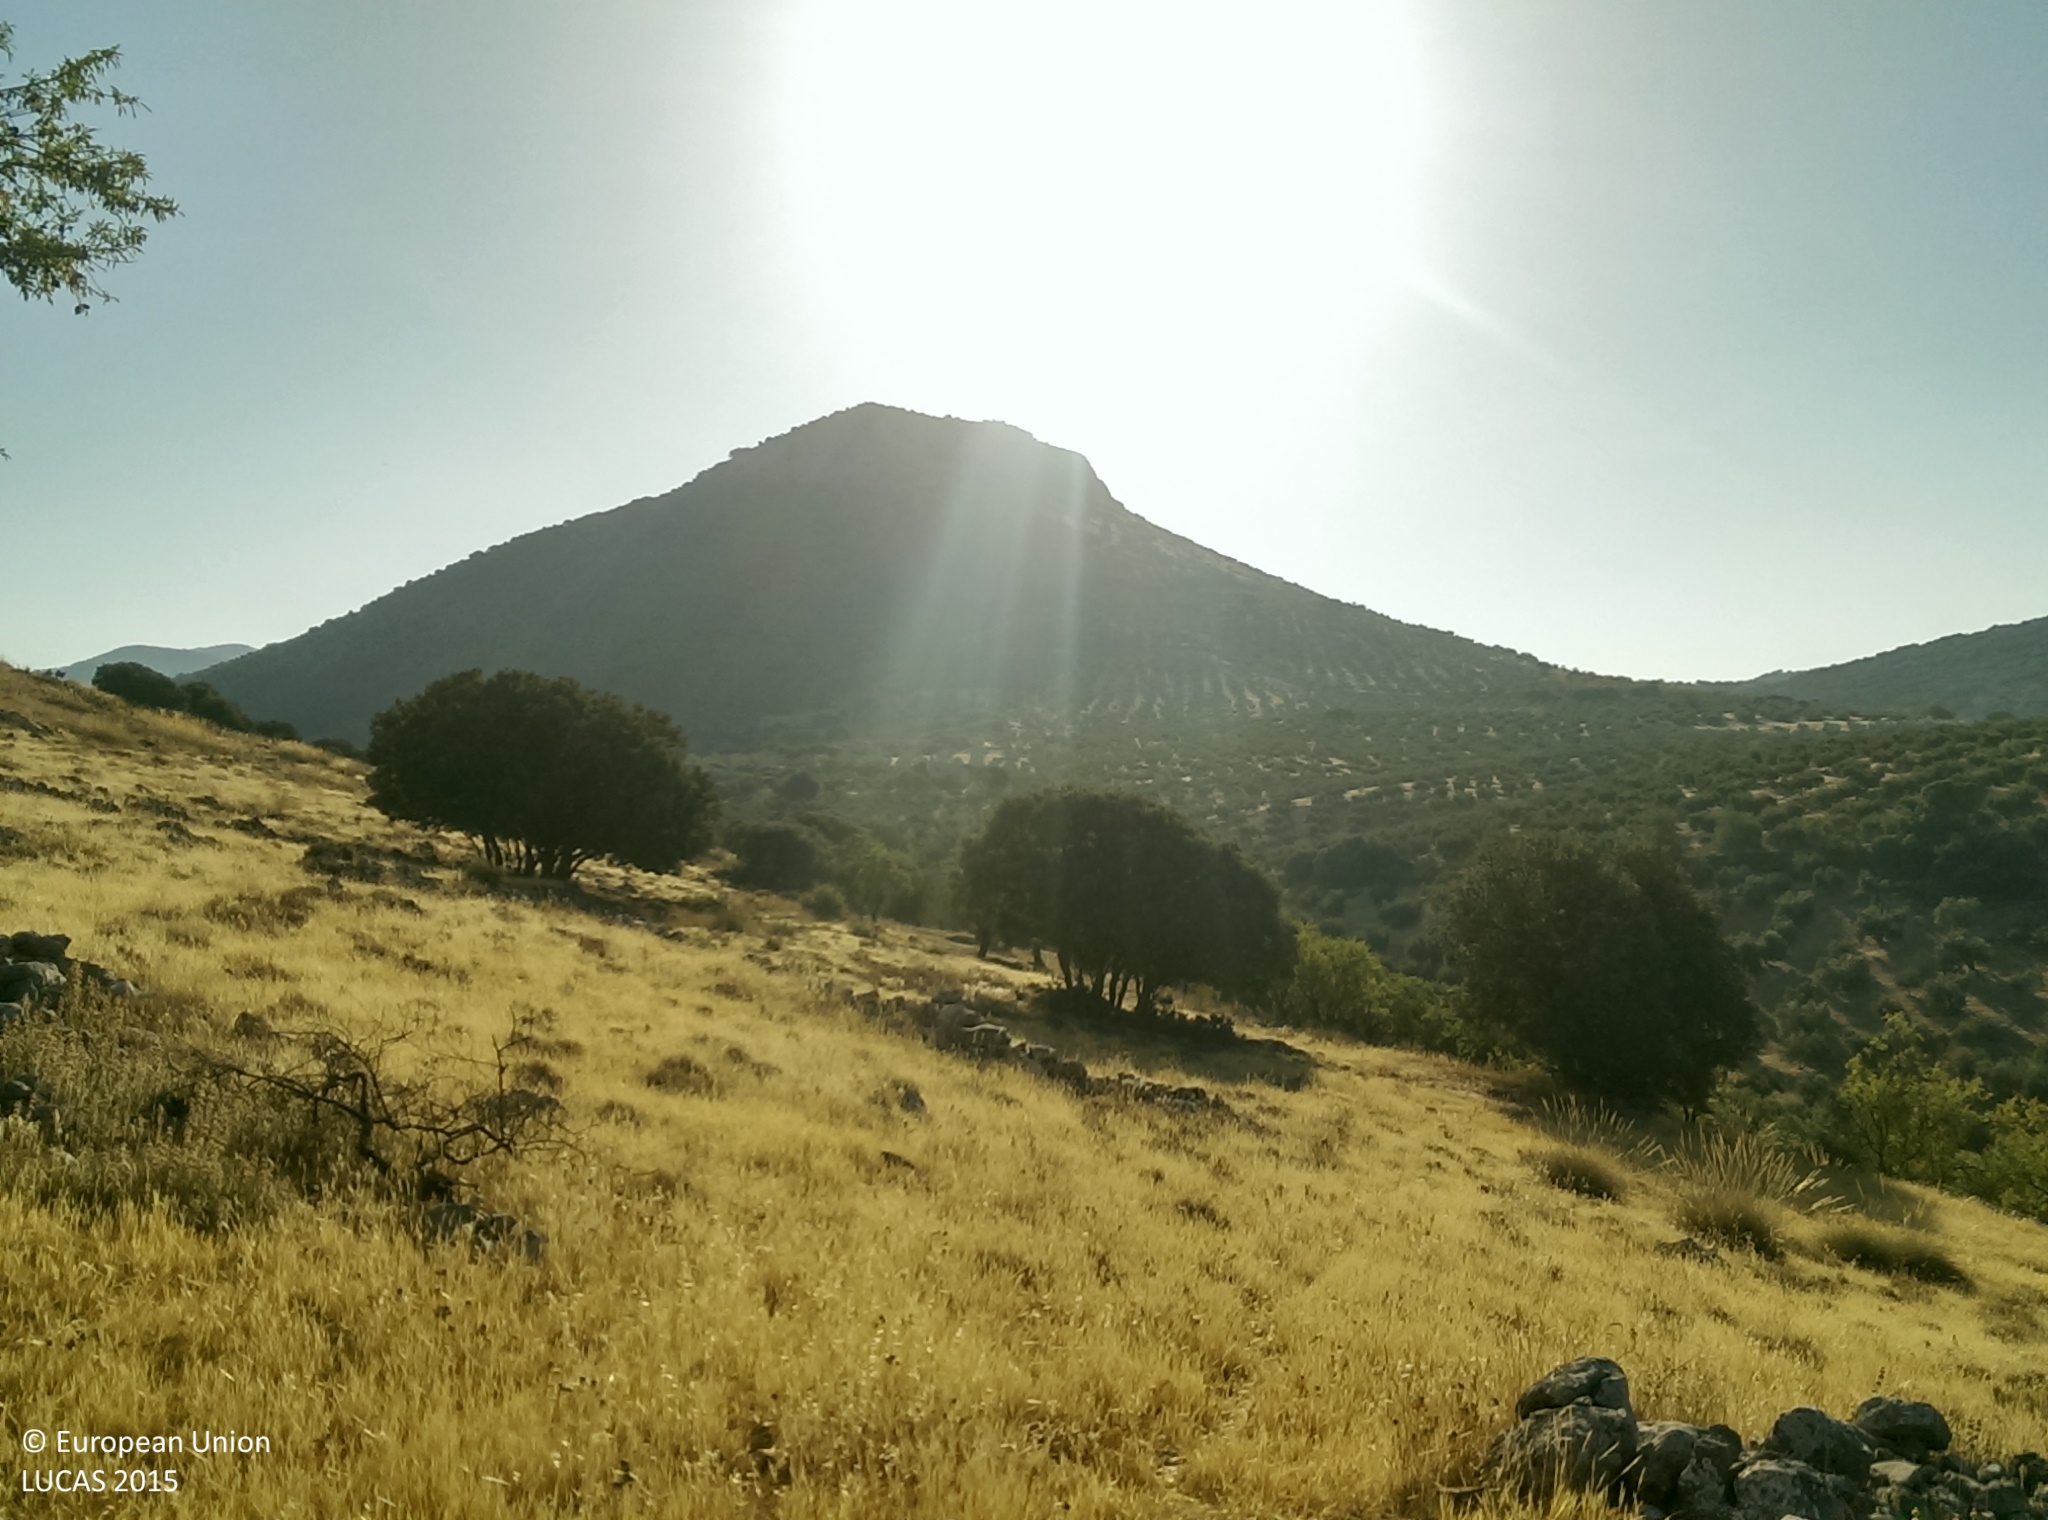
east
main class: Grassland
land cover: Grassland without tree/shrub cover
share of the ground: > 75 %
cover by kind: herbaceous plants 100 %
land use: Agriculture (excluding fallow land and kitchen gardens)
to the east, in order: Grassland without tree/shrub cover; Grassland with sparse tree/shrub cover; Dry stone walls; Nuts trees; Dry stone walls; Olive groves; Other structural elements; Tracks; Rivers and streams; Olive groves
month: July
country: ES
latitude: 37.3765
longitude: -3.6917
